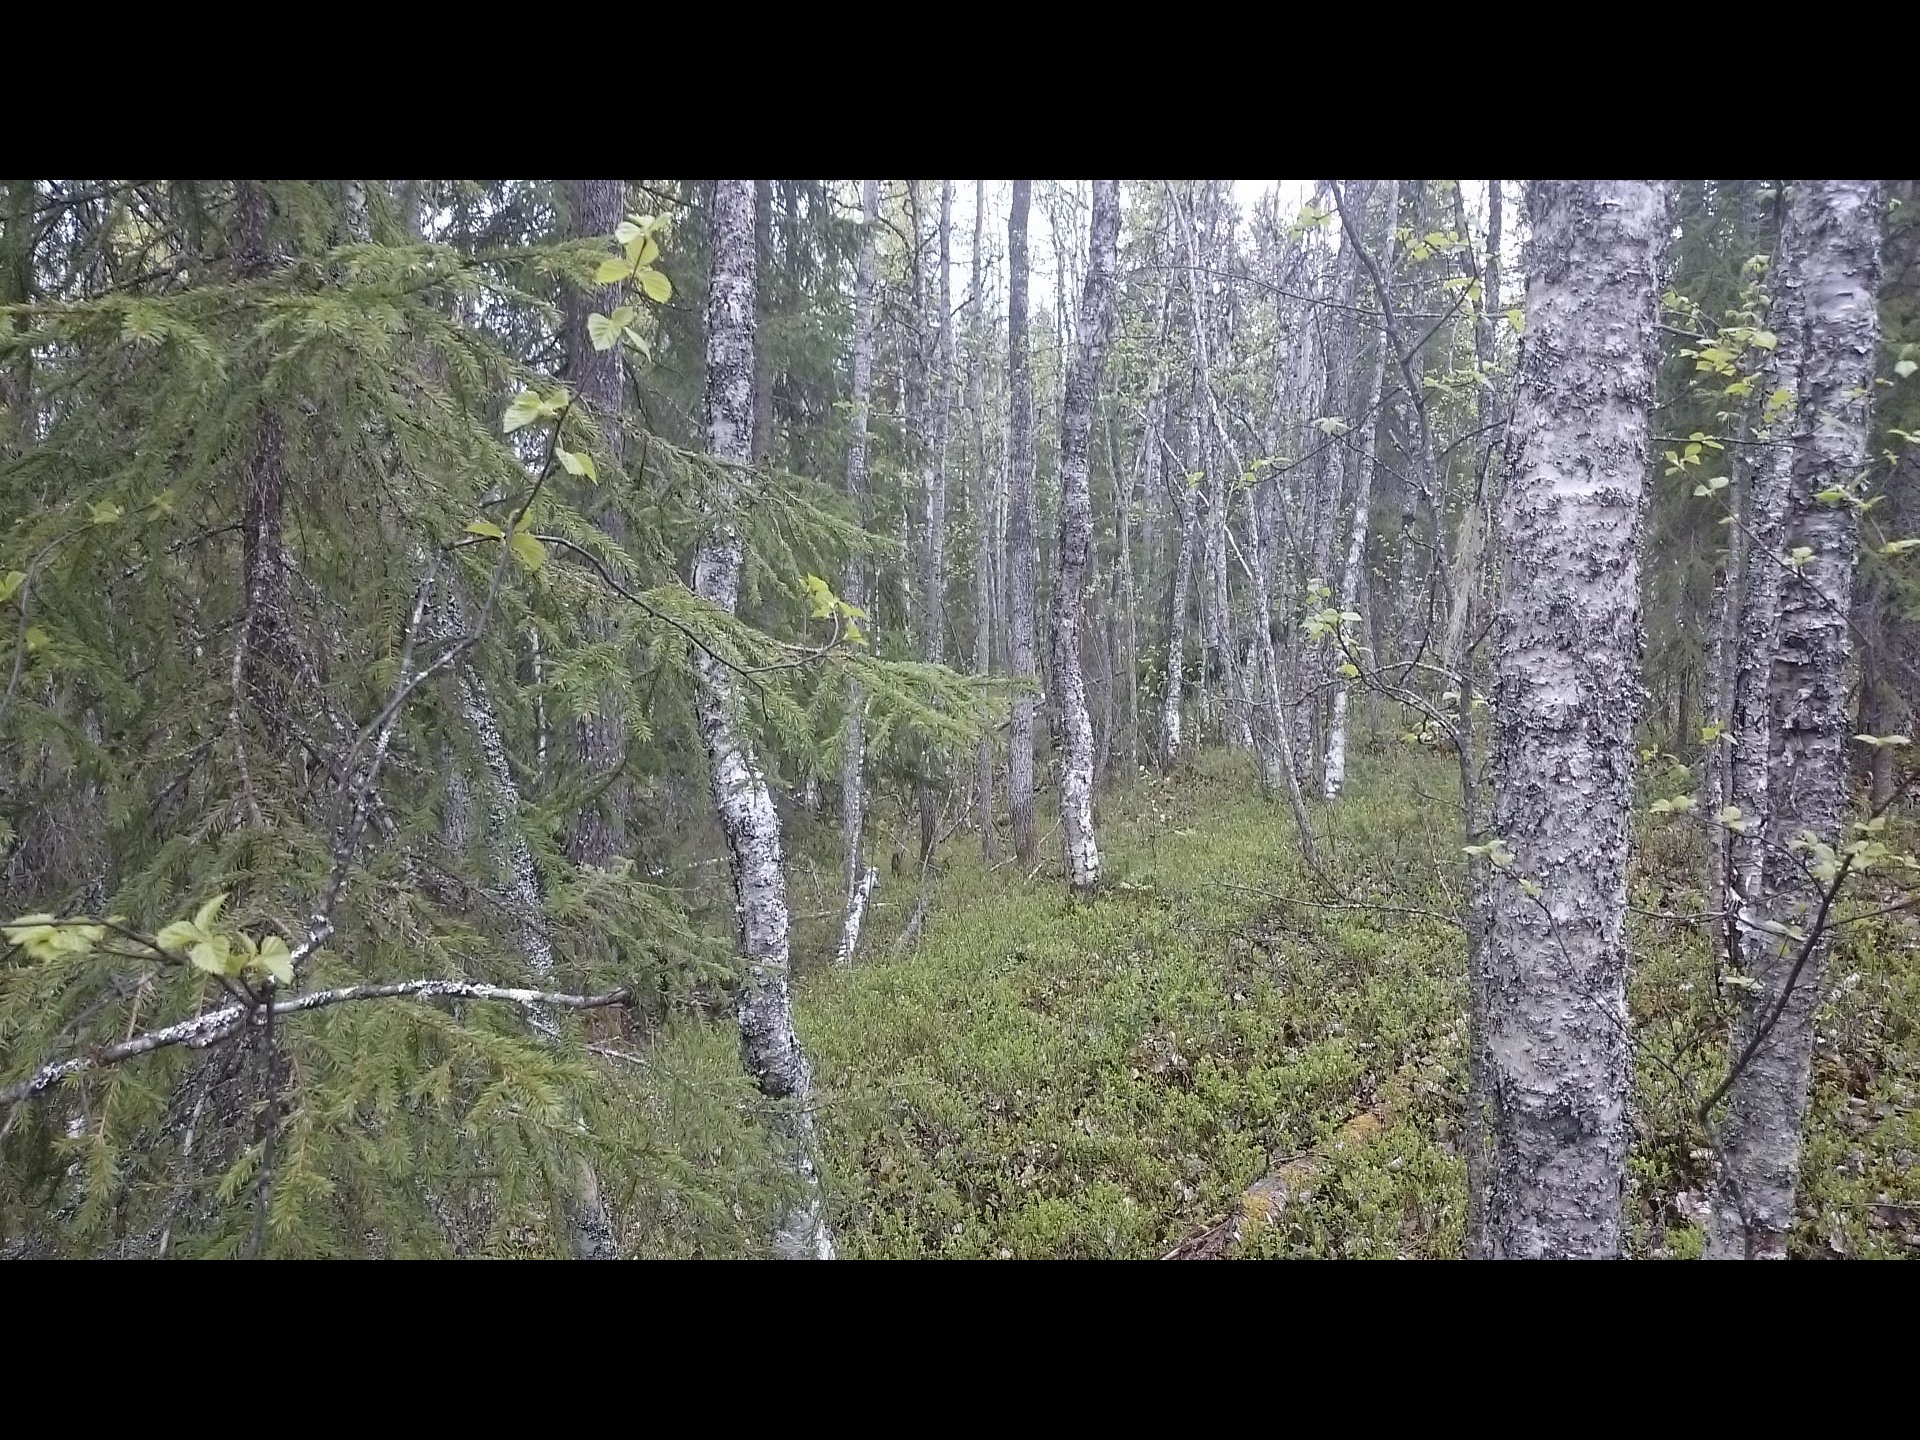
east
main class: Woodland
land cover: Spruce dominated mixed woodland
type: boreal forest
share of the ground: > 75 %
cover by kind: coniferous forest trees 60 %, broadleaved forest trees 20 %, shrubs 15 %, herbaceous plants 5 %
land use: Forestry
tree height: > 5 m
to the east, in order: Spruce dominated mixed woodland; Paved roads, cycling and walking lanes; Spruce dominated mixed woodland; Grassland without tree/shrub cover; Spruce dominated mixed woodland; Paved roads, cycling and walking lanes; Spruce dominated mixed woodland; Inland fresh water bodies
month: June
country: SE
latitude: 63.6469
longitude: 13.8363
